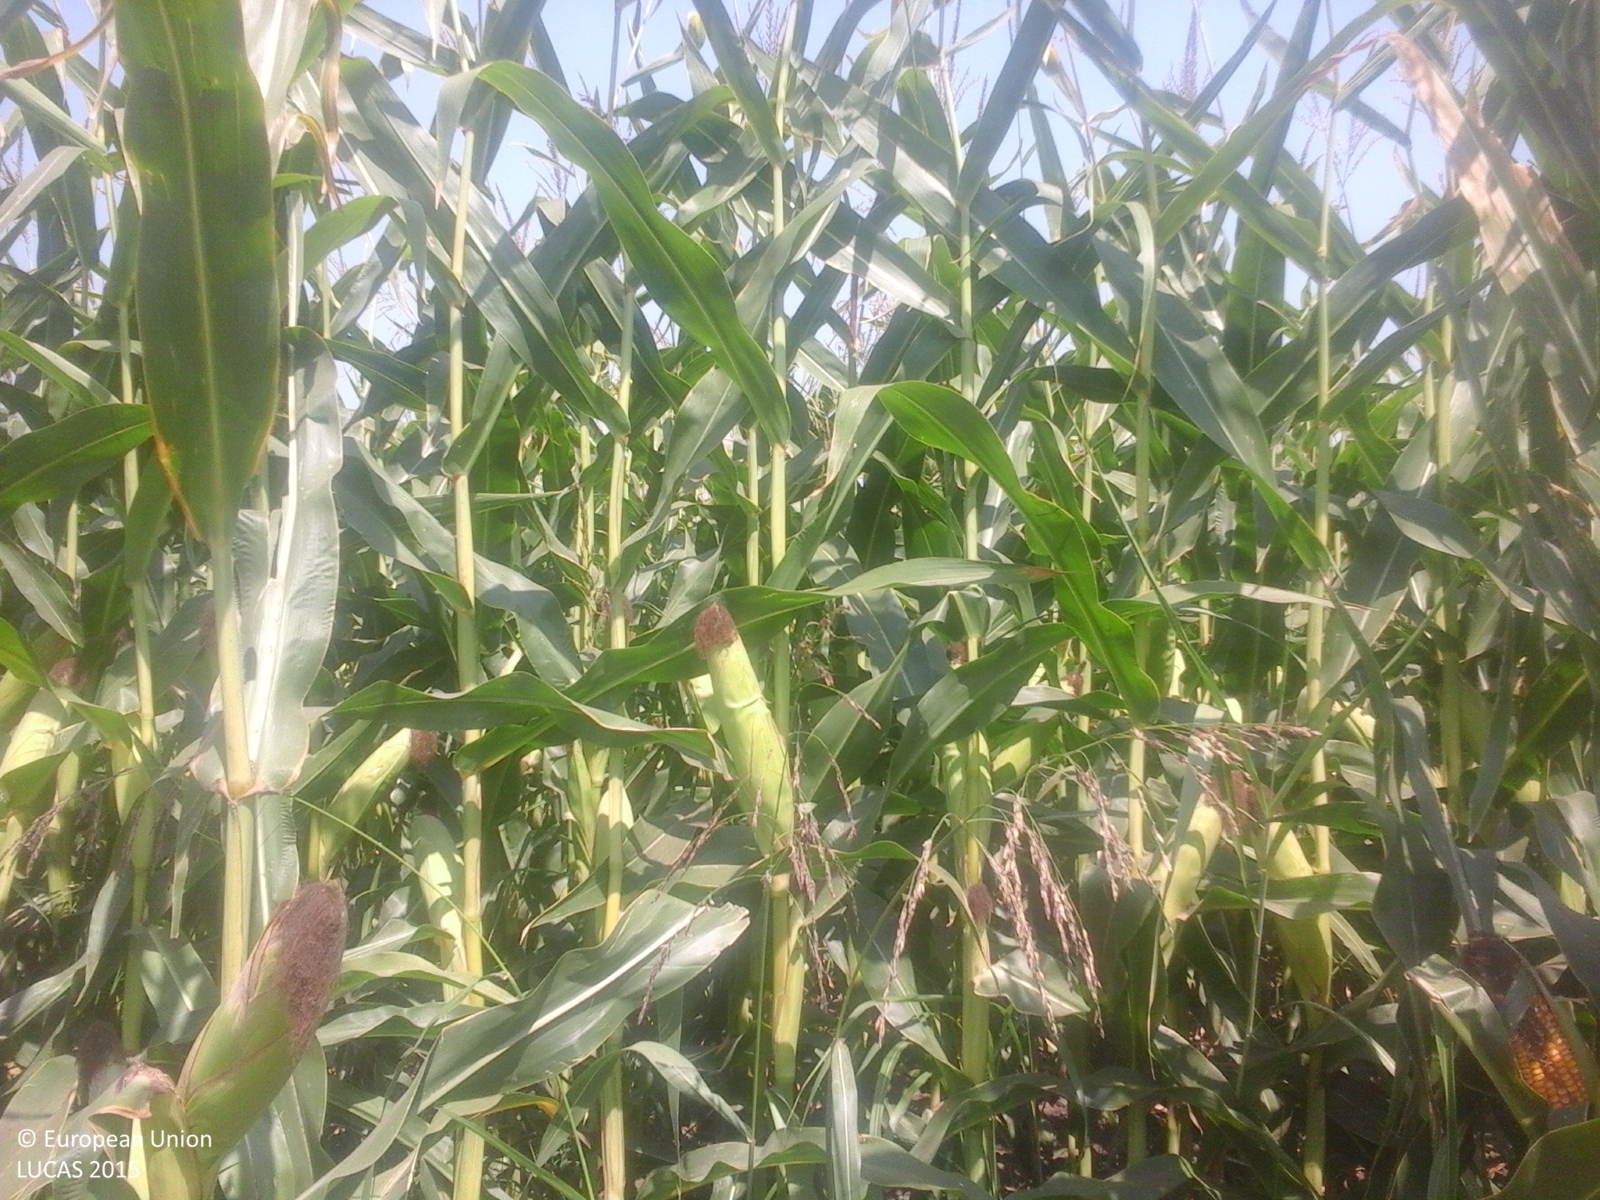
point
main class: Cropland
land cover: Maize
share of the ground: > 75 %
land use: Agriculture (excluding fallow land and kitchen gardens)
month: August
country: RO
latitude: 45.1418
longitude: 27.6665
